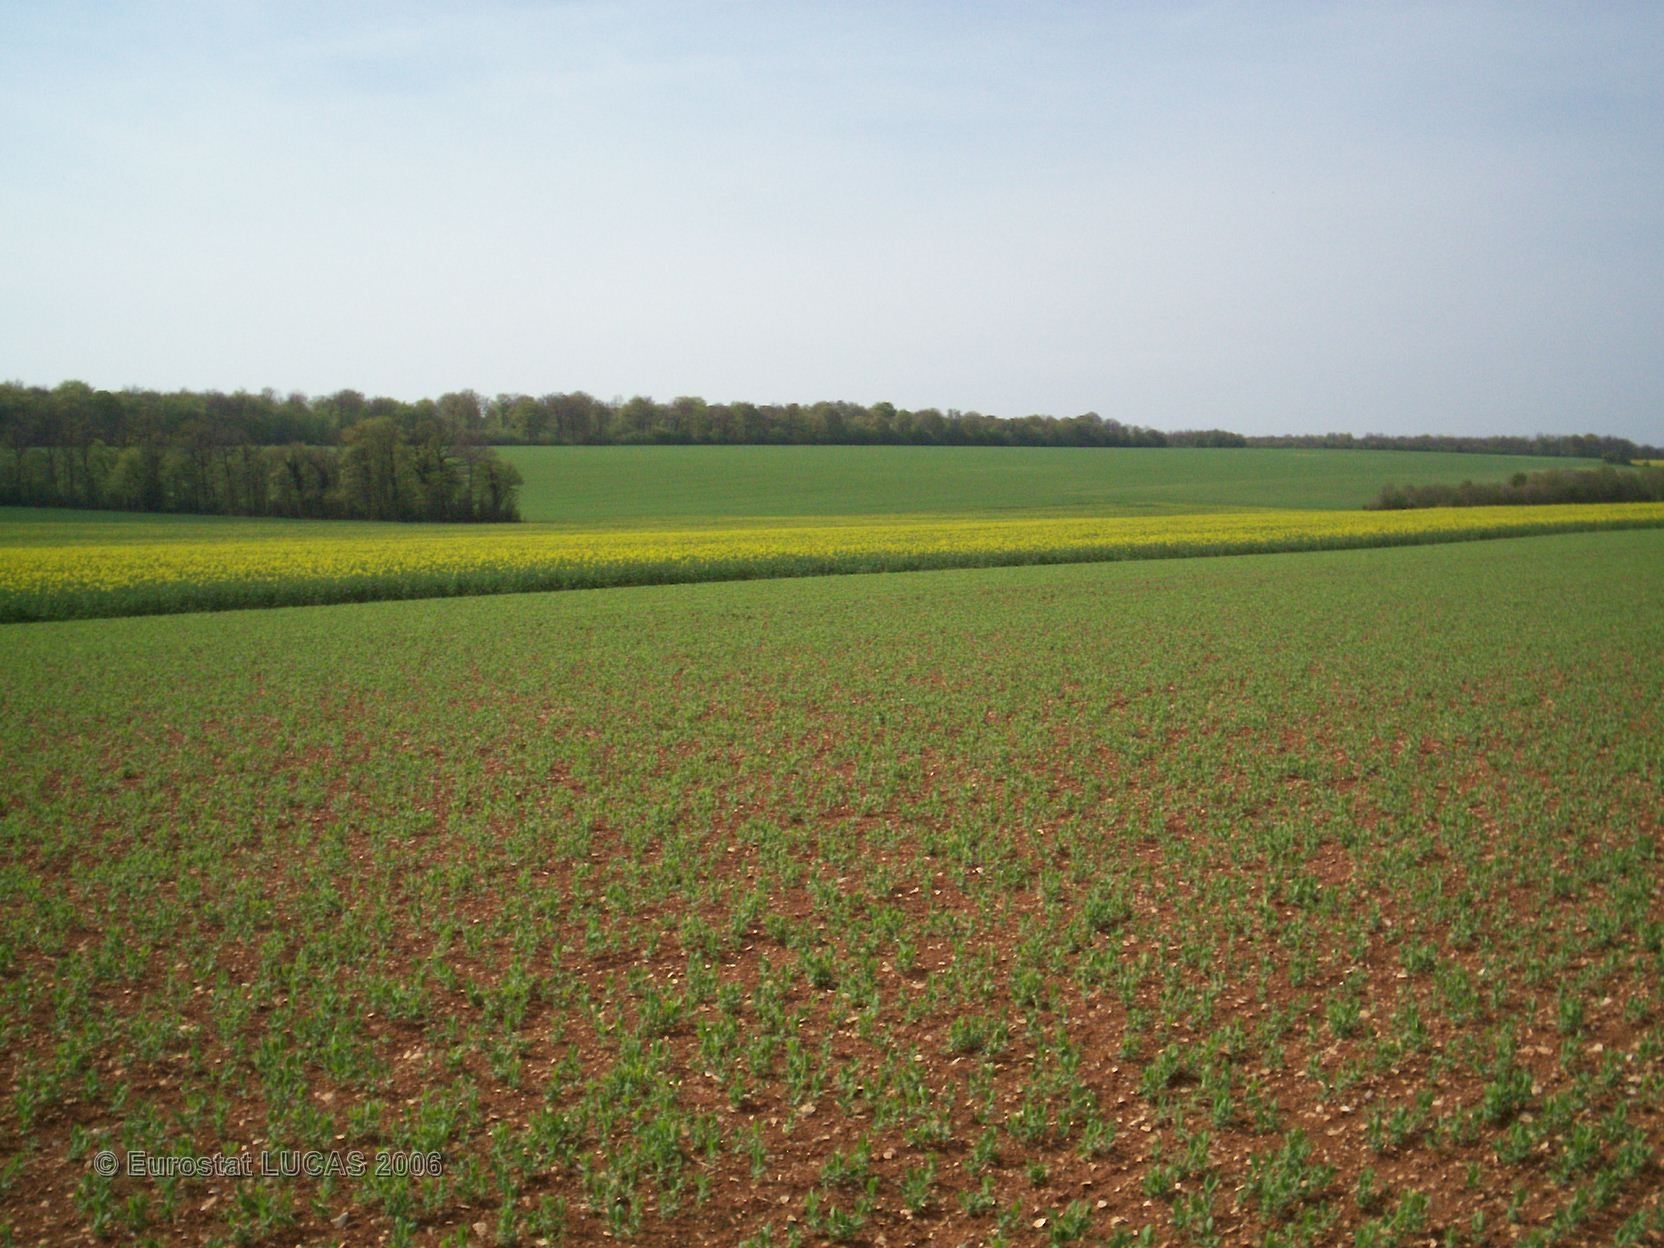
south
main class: Cropland
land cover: Dry pulses
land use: Agriculture (excluding fallow land and kitchen gardens)
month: May
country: FR
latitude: 47.6228
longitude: 4.6101
